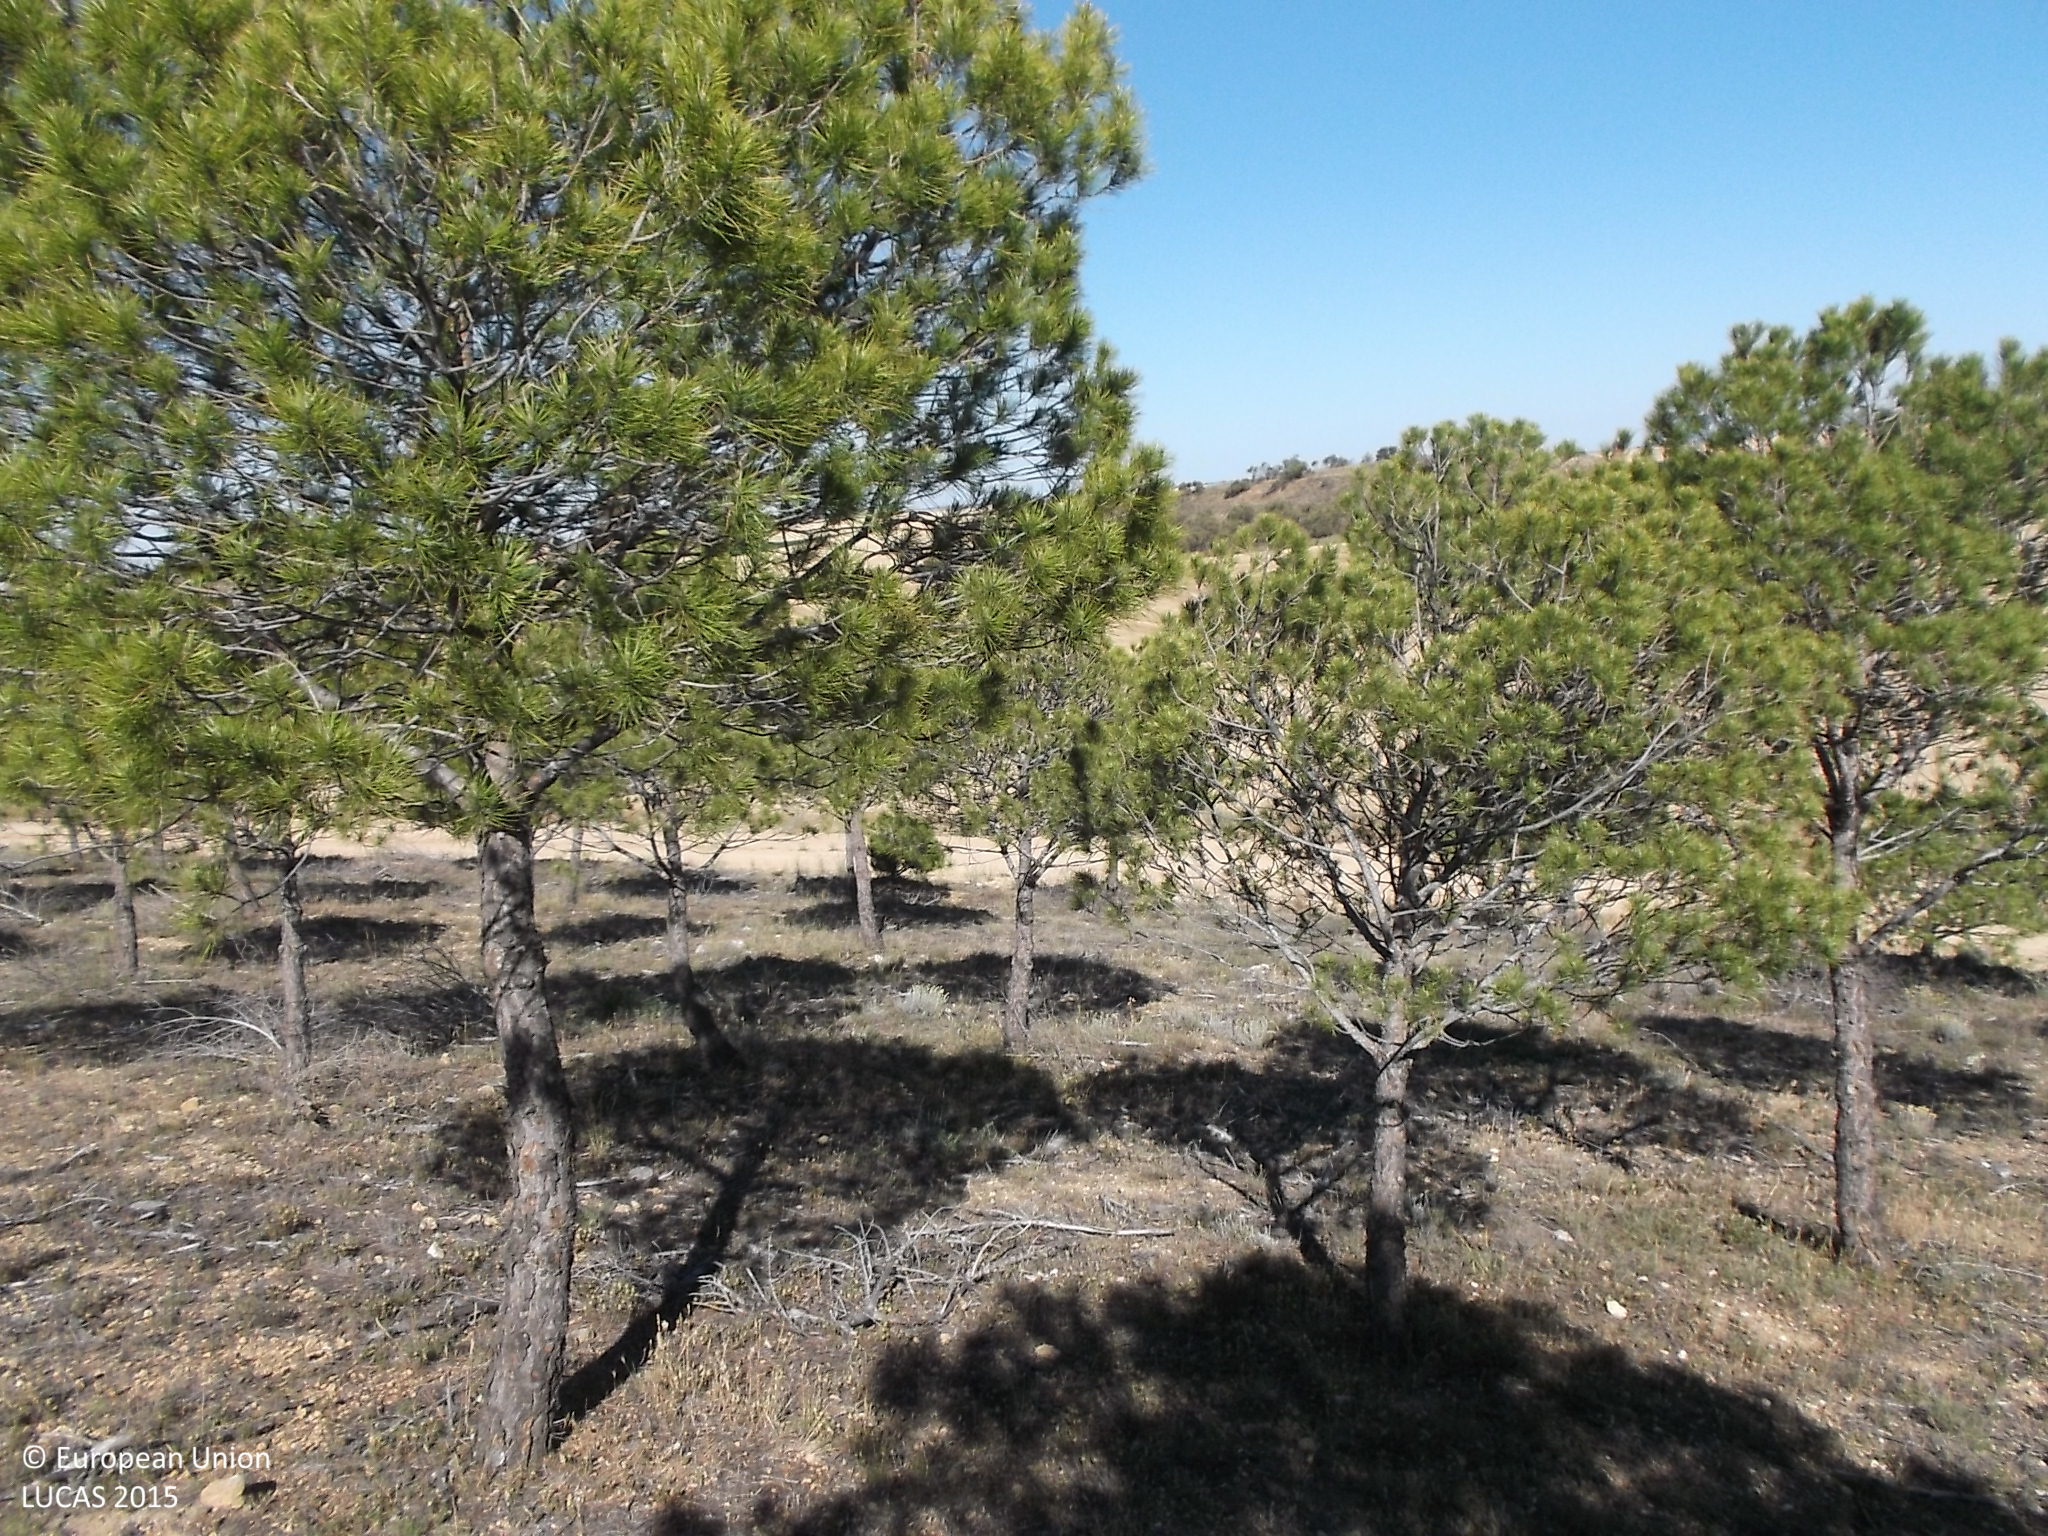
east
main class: Woodland
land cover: Pine dominated coniferous woodland
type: coniferous forest of the mediterranean region
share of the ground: 25 - 50 %
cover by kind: herbaceous plants 65 %, coniferous forest trees 35 %
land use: Forestry
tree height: < 5 m
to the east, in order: Pine dominated coniferous woodland; Grass margins; Tracks; Grassland without tree/shrub cover; Common wheat; Barley
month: June
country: ES
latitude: 41.3175
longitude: -5.3064
